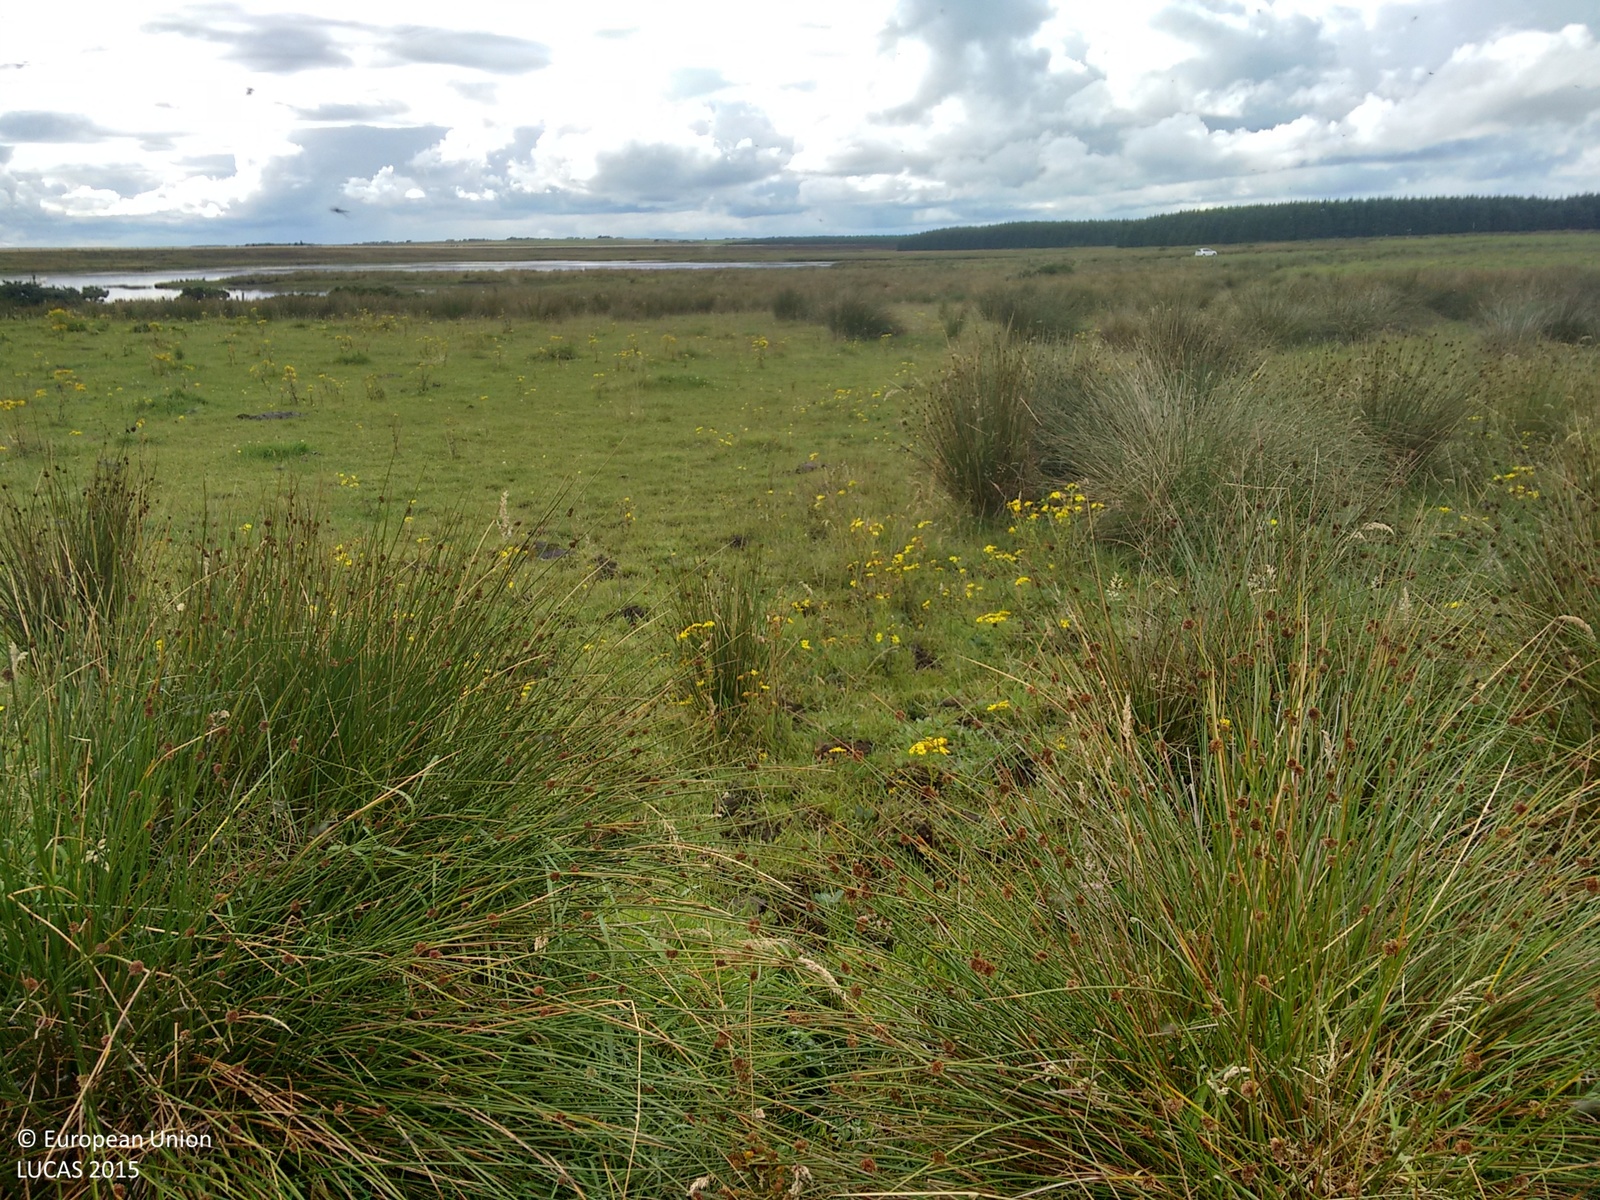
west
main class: Grassland
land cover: Grassland without tree/shrub cover
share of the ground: > 75 %
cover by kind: herbaceous plants 100 %
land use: Agriculture (excluding fallow land and kitchen gardens)
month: August
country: GB
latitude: 58.5188
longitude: -3.1577
